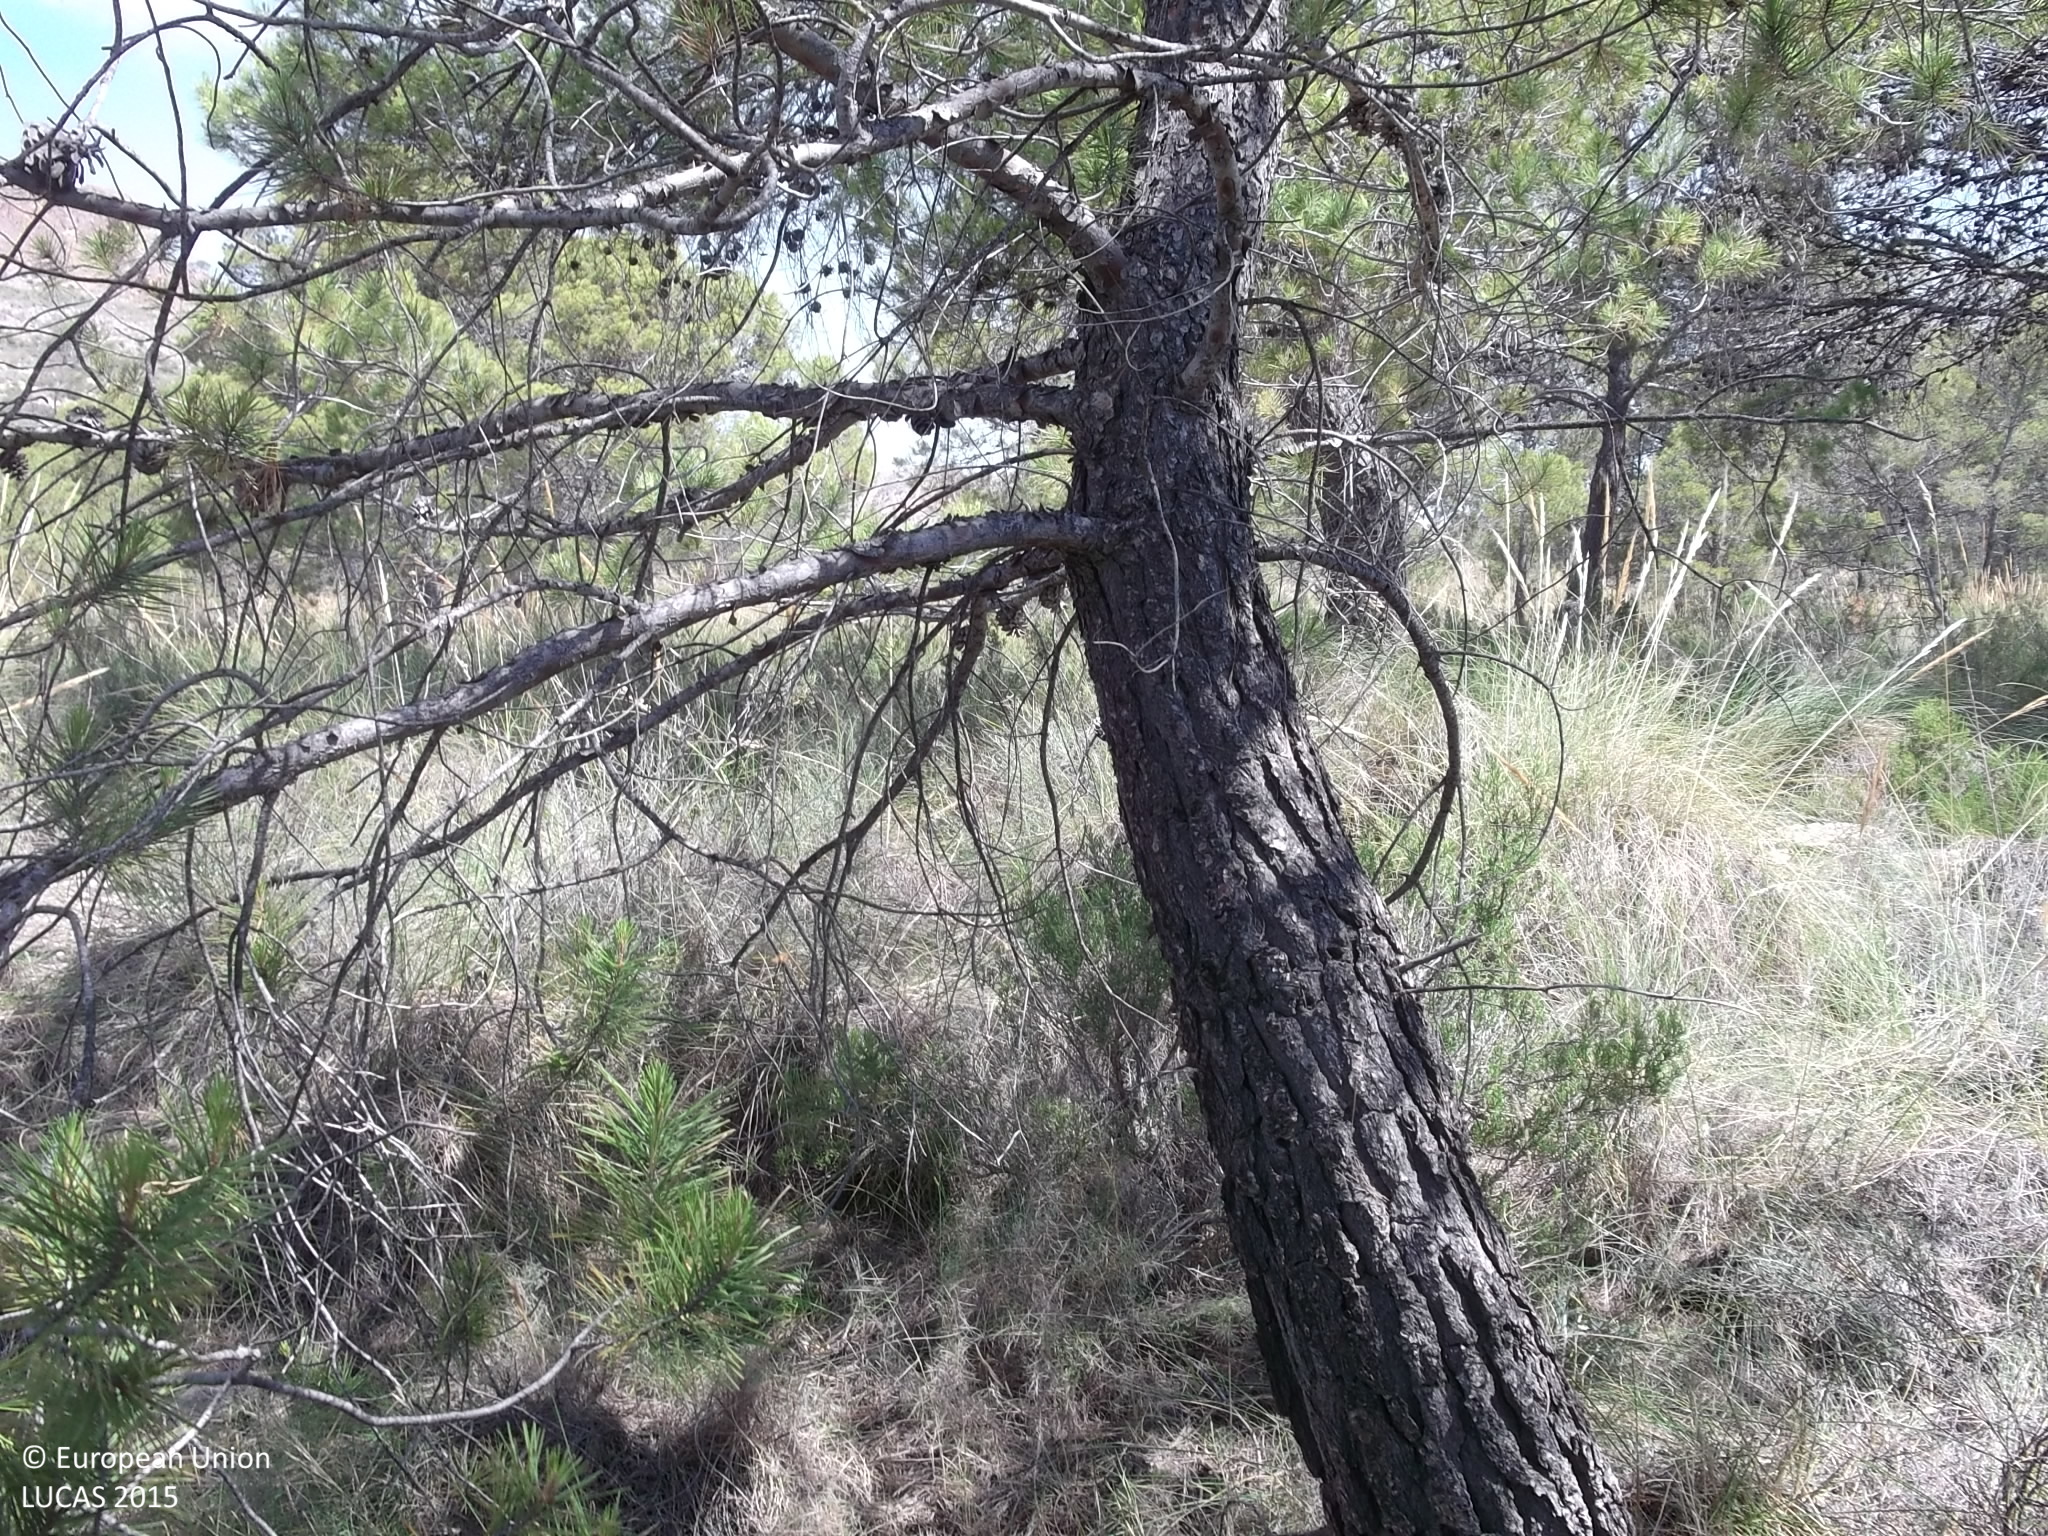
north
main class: Woodland
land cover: Pine dominated coniferous woodland
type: coniferous forest of the mediterranean region
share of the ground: 25 - 50 %
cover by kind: shrubs 35 %, coniferous forest trees 25 %, herbaceous plants 20 %, consolidated bare surface 20 %
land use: Semi-natural and natural areas not in use
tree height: > 5 m
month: June
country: ES
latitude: 38.4023
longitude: -1.3378
